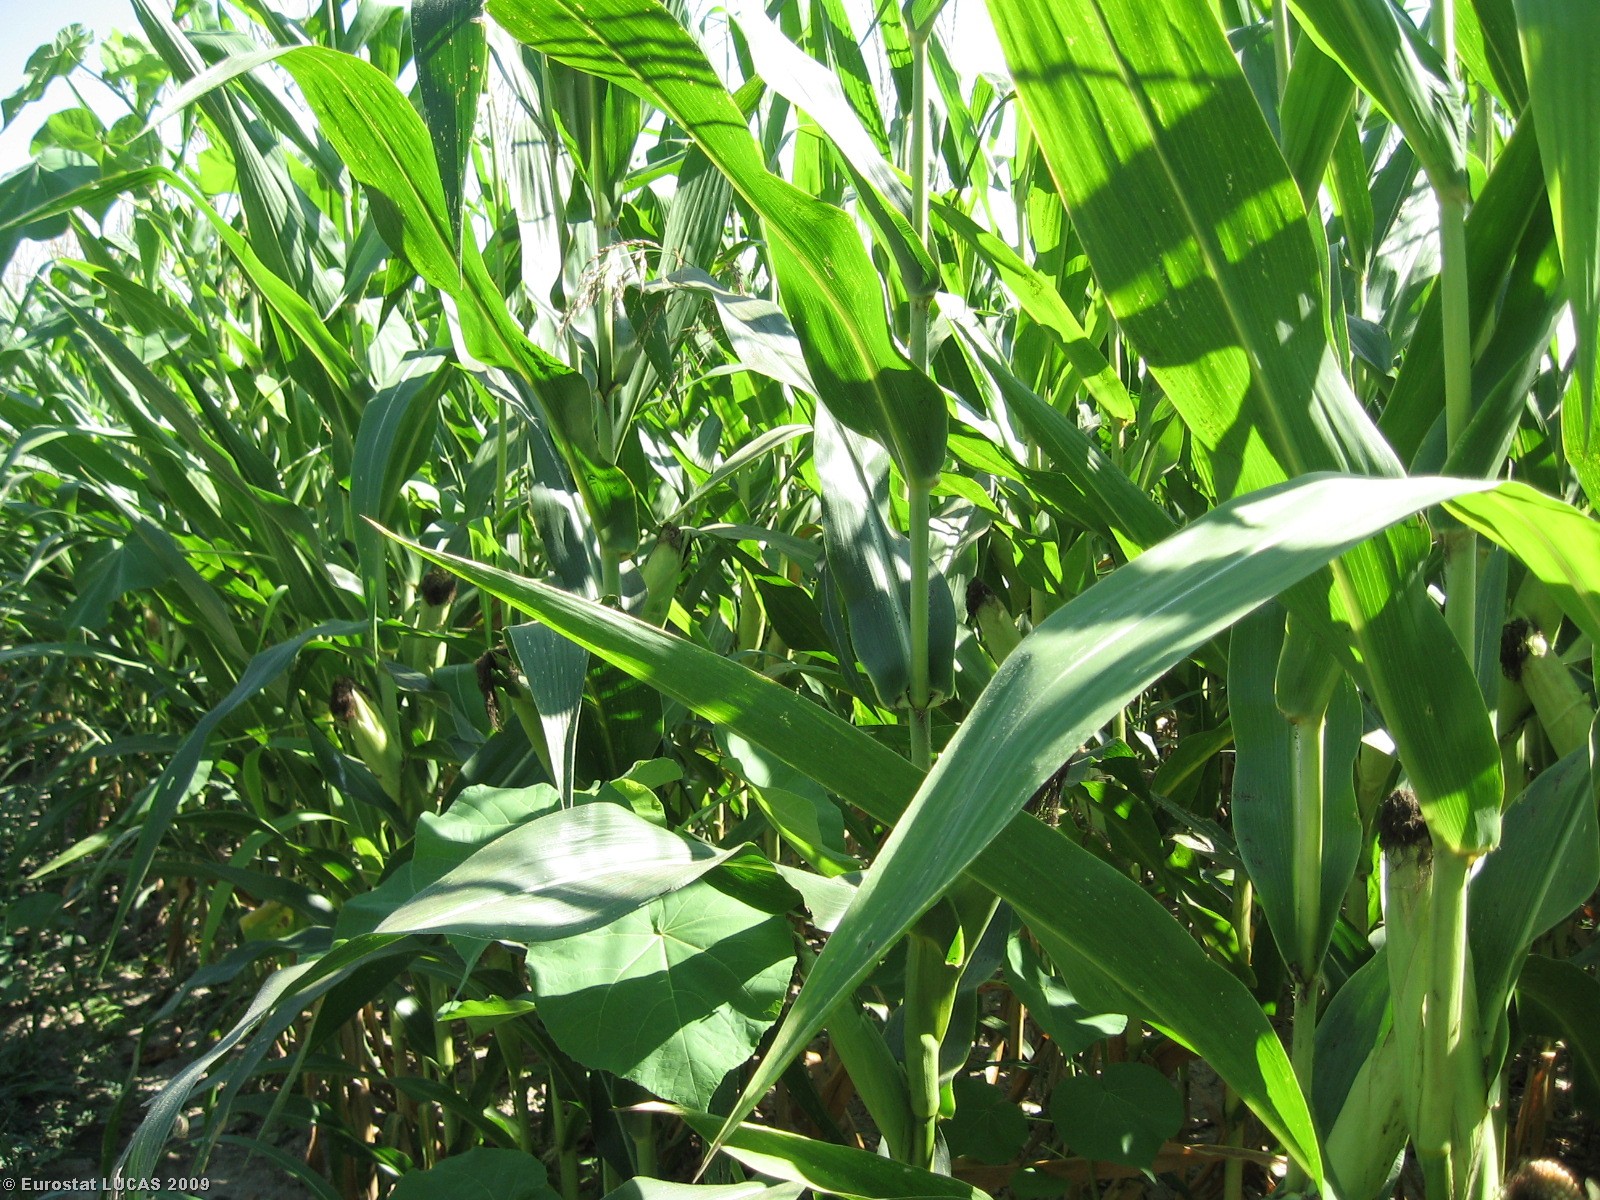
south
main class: Cropland
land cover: Maize
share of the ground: > 75 %
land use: Agriculture (excluding fallow land and kitchen gardens)
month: August
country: IT
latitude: 45.0887
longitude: 9.5054
